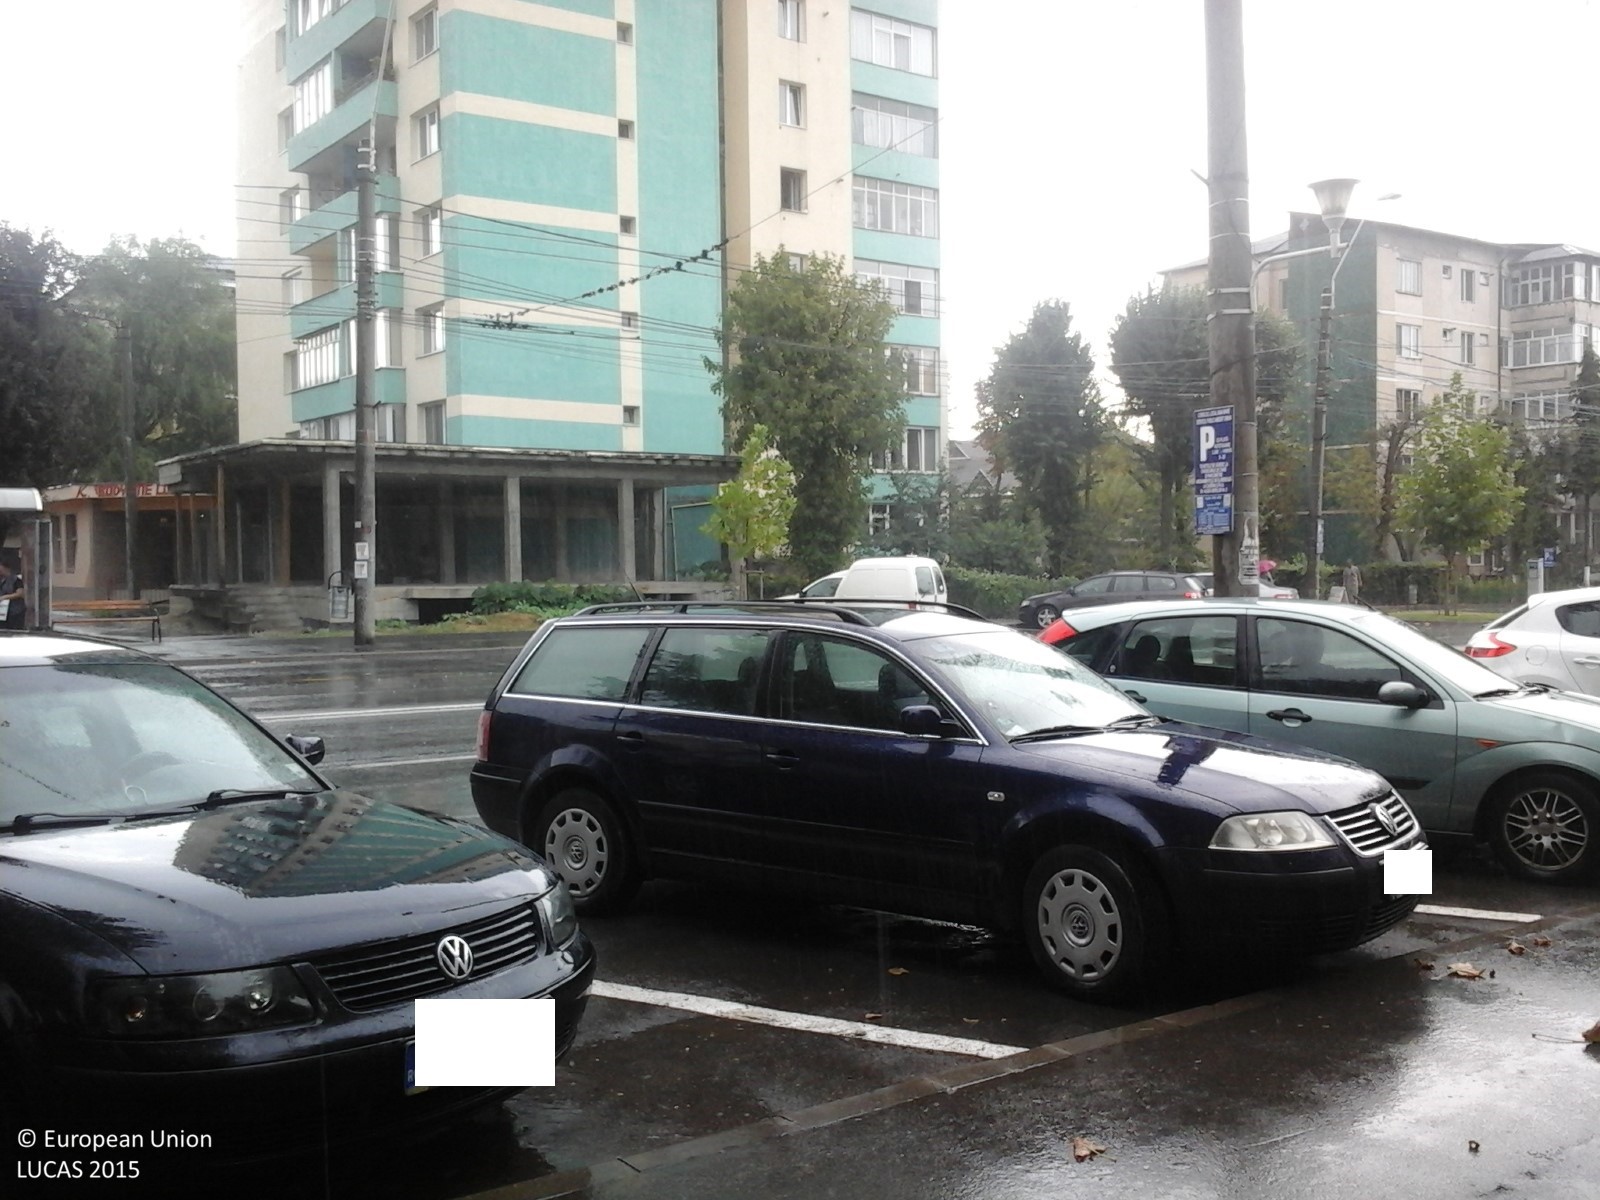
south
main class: Grassland
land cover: Grassland with sparse tree/shrub cover
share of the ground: > 75 %
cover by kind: herbaceous plants 95 %, broadleaved forest trees 5 %
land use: Residential
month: September
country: RO
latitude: 47.6542
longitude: 23.5631
